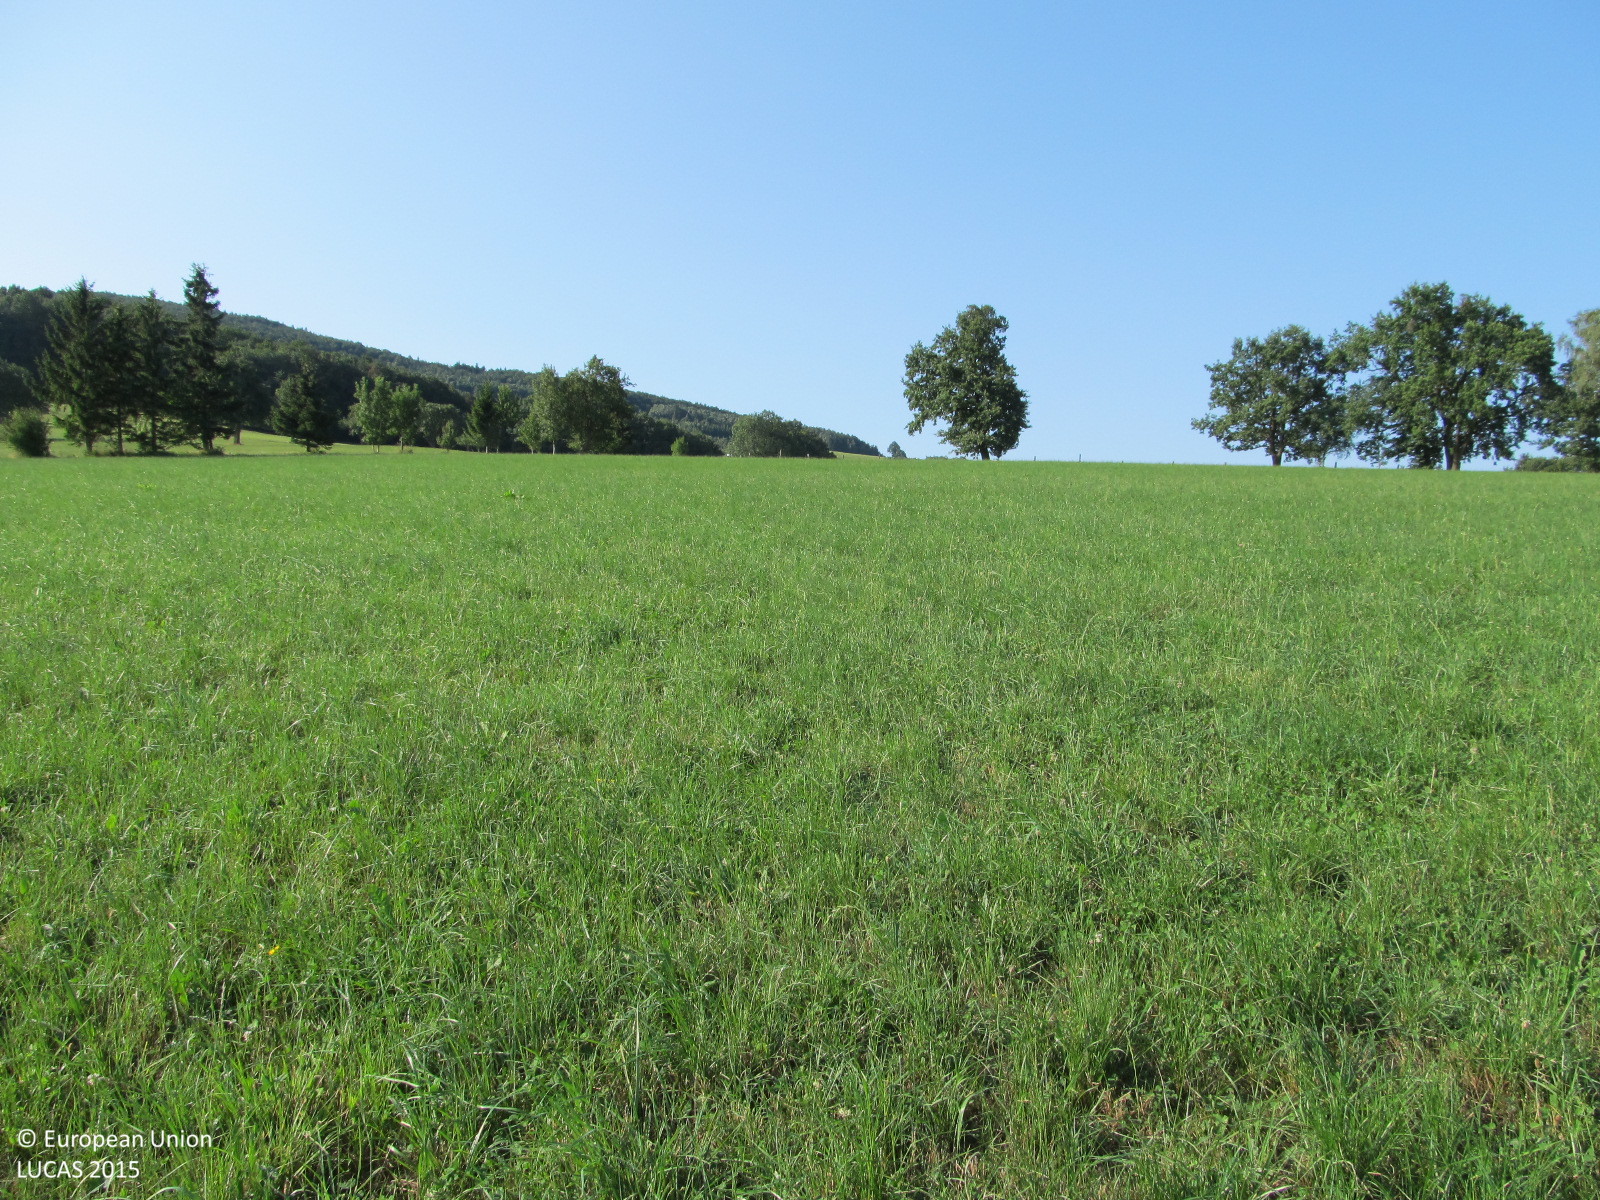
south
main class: Grassland
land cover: Grassland without tree/shrub cover
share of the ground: > 75 %
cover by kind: herbaceous plants 100 %
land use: Agriculture (excluding fallow land and kitchen gardens)
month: August
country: AT
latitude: 48.1447
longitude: 15.7687
